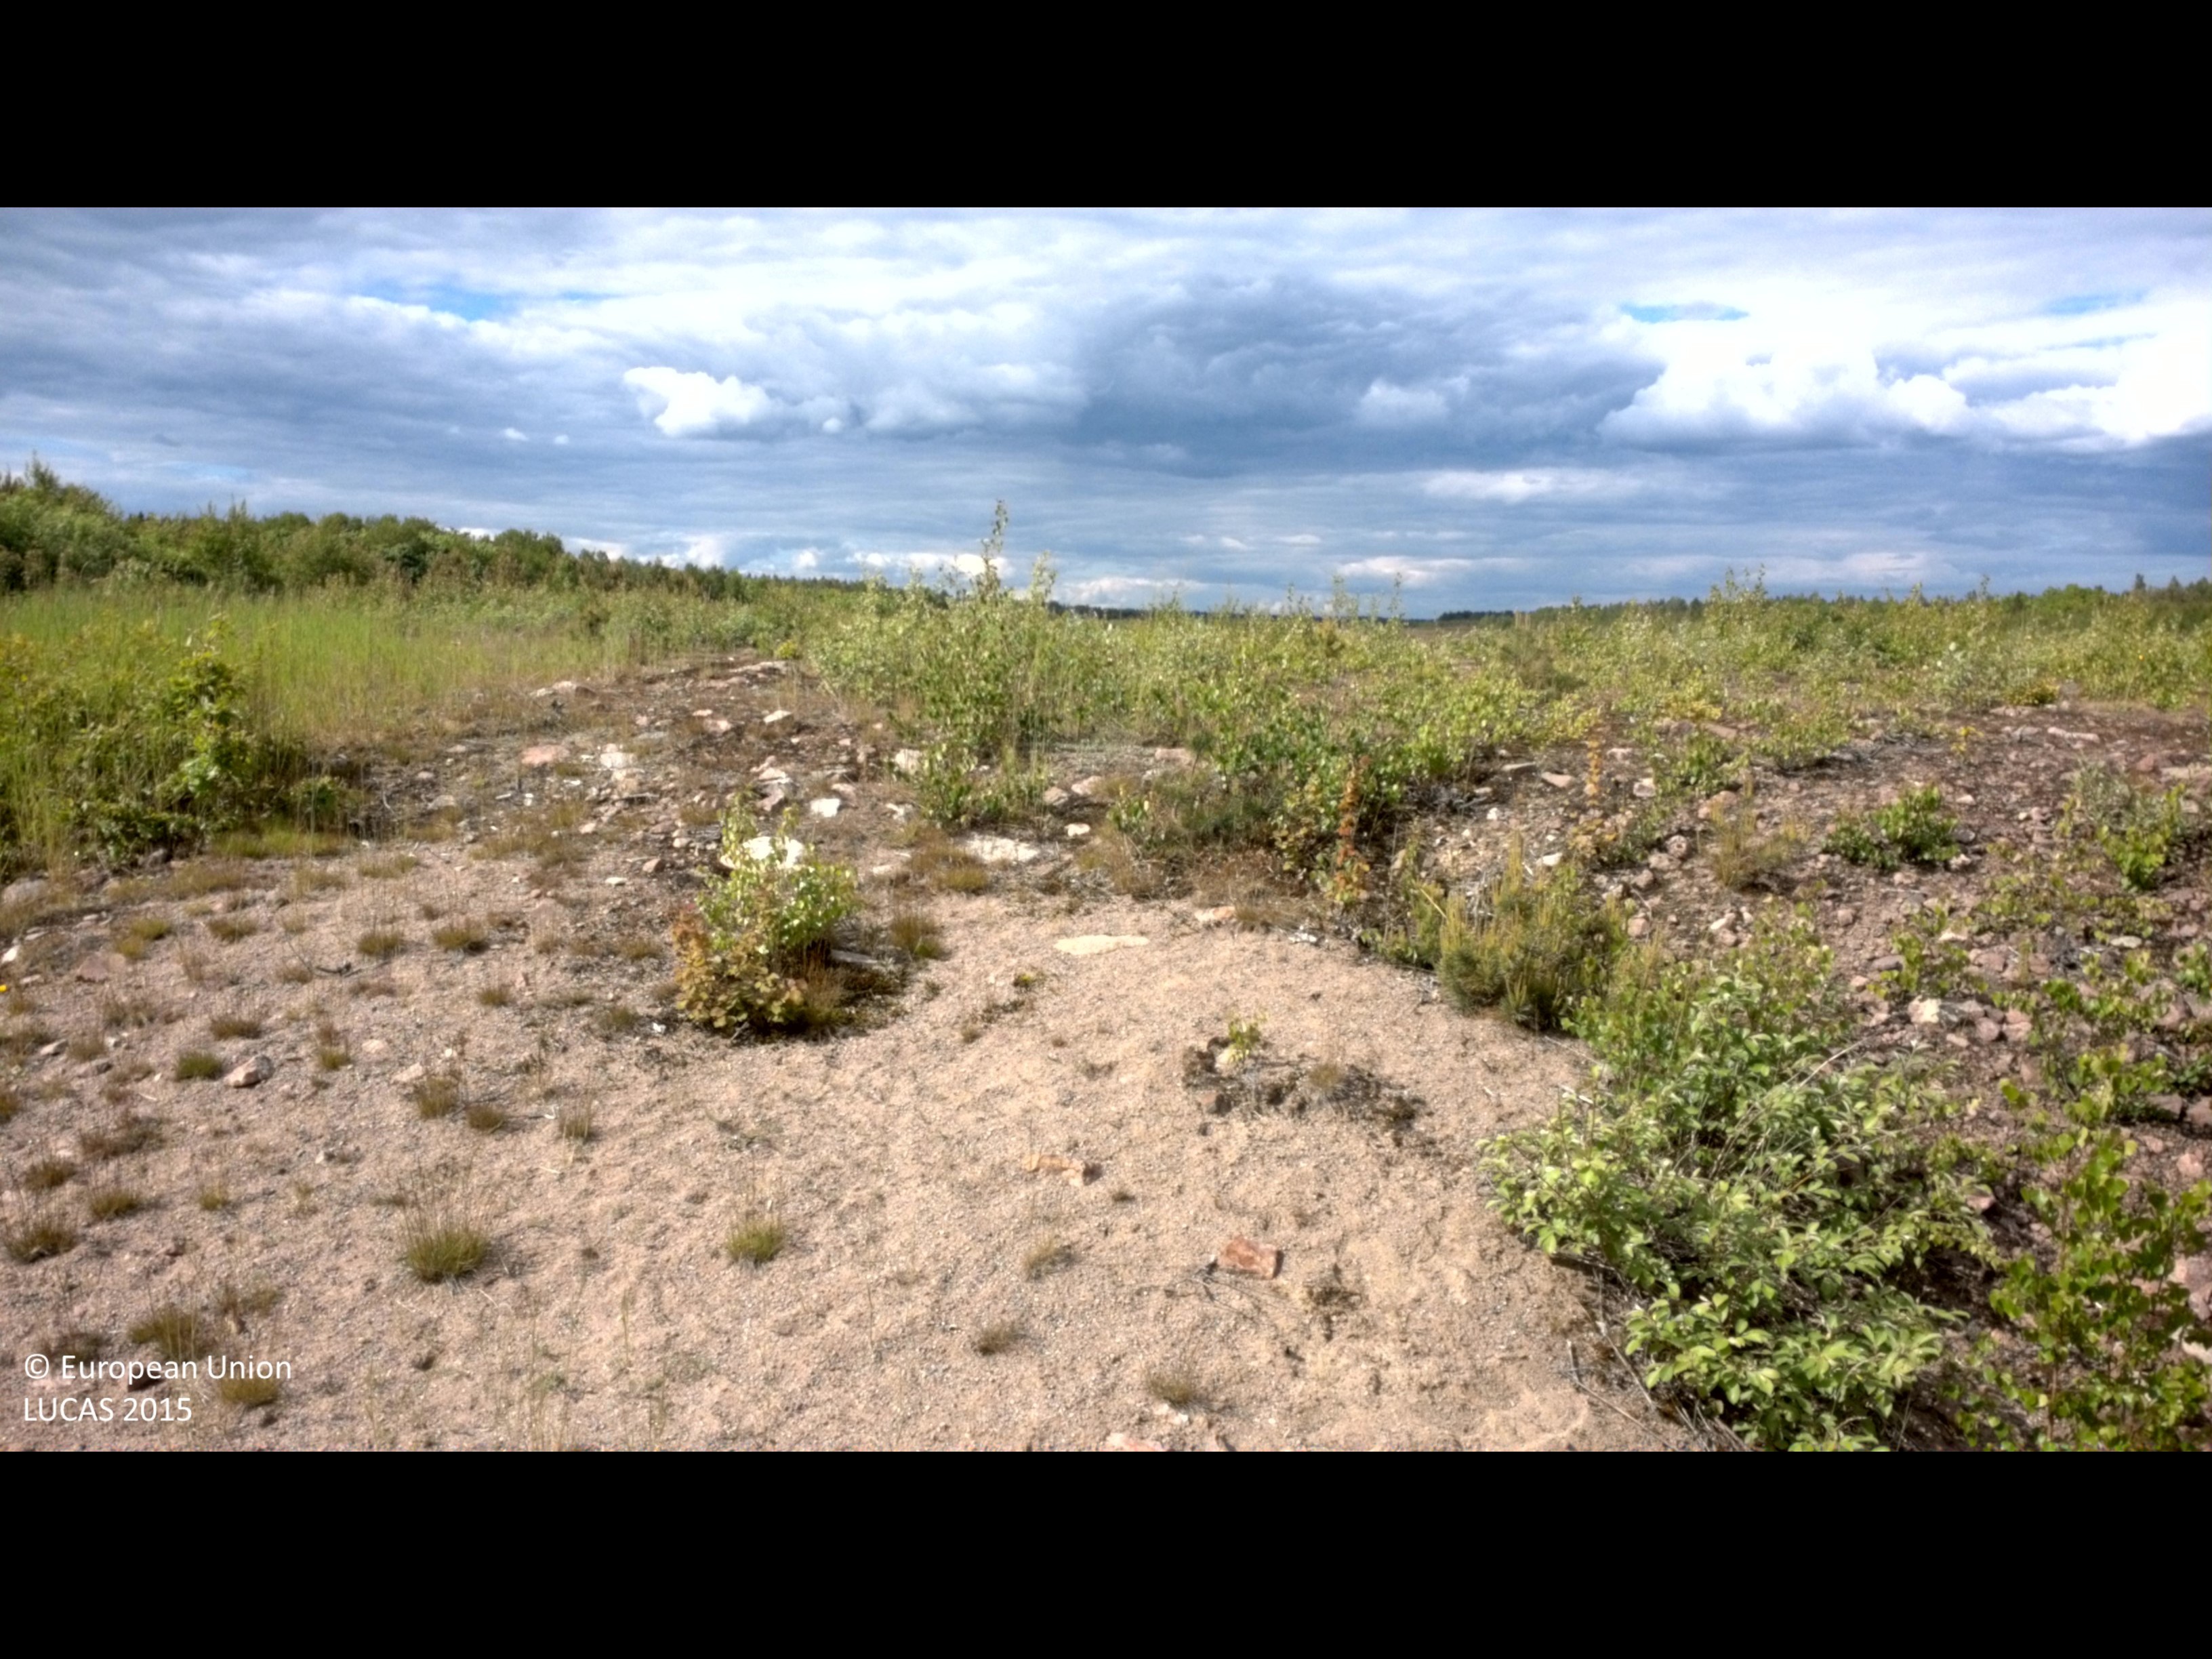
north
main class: Shrubland
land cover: Shrubland with sparse tree cover
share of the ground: > 75 %
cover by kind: shrubs 45 %, unconsolidated bare surface 30 %, herbaceous plants 10 %, broadleaved forest trees 5 %
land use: Air transport
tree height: < 5 m
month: May
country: SE
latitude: 57.3405
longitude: 16.4960
